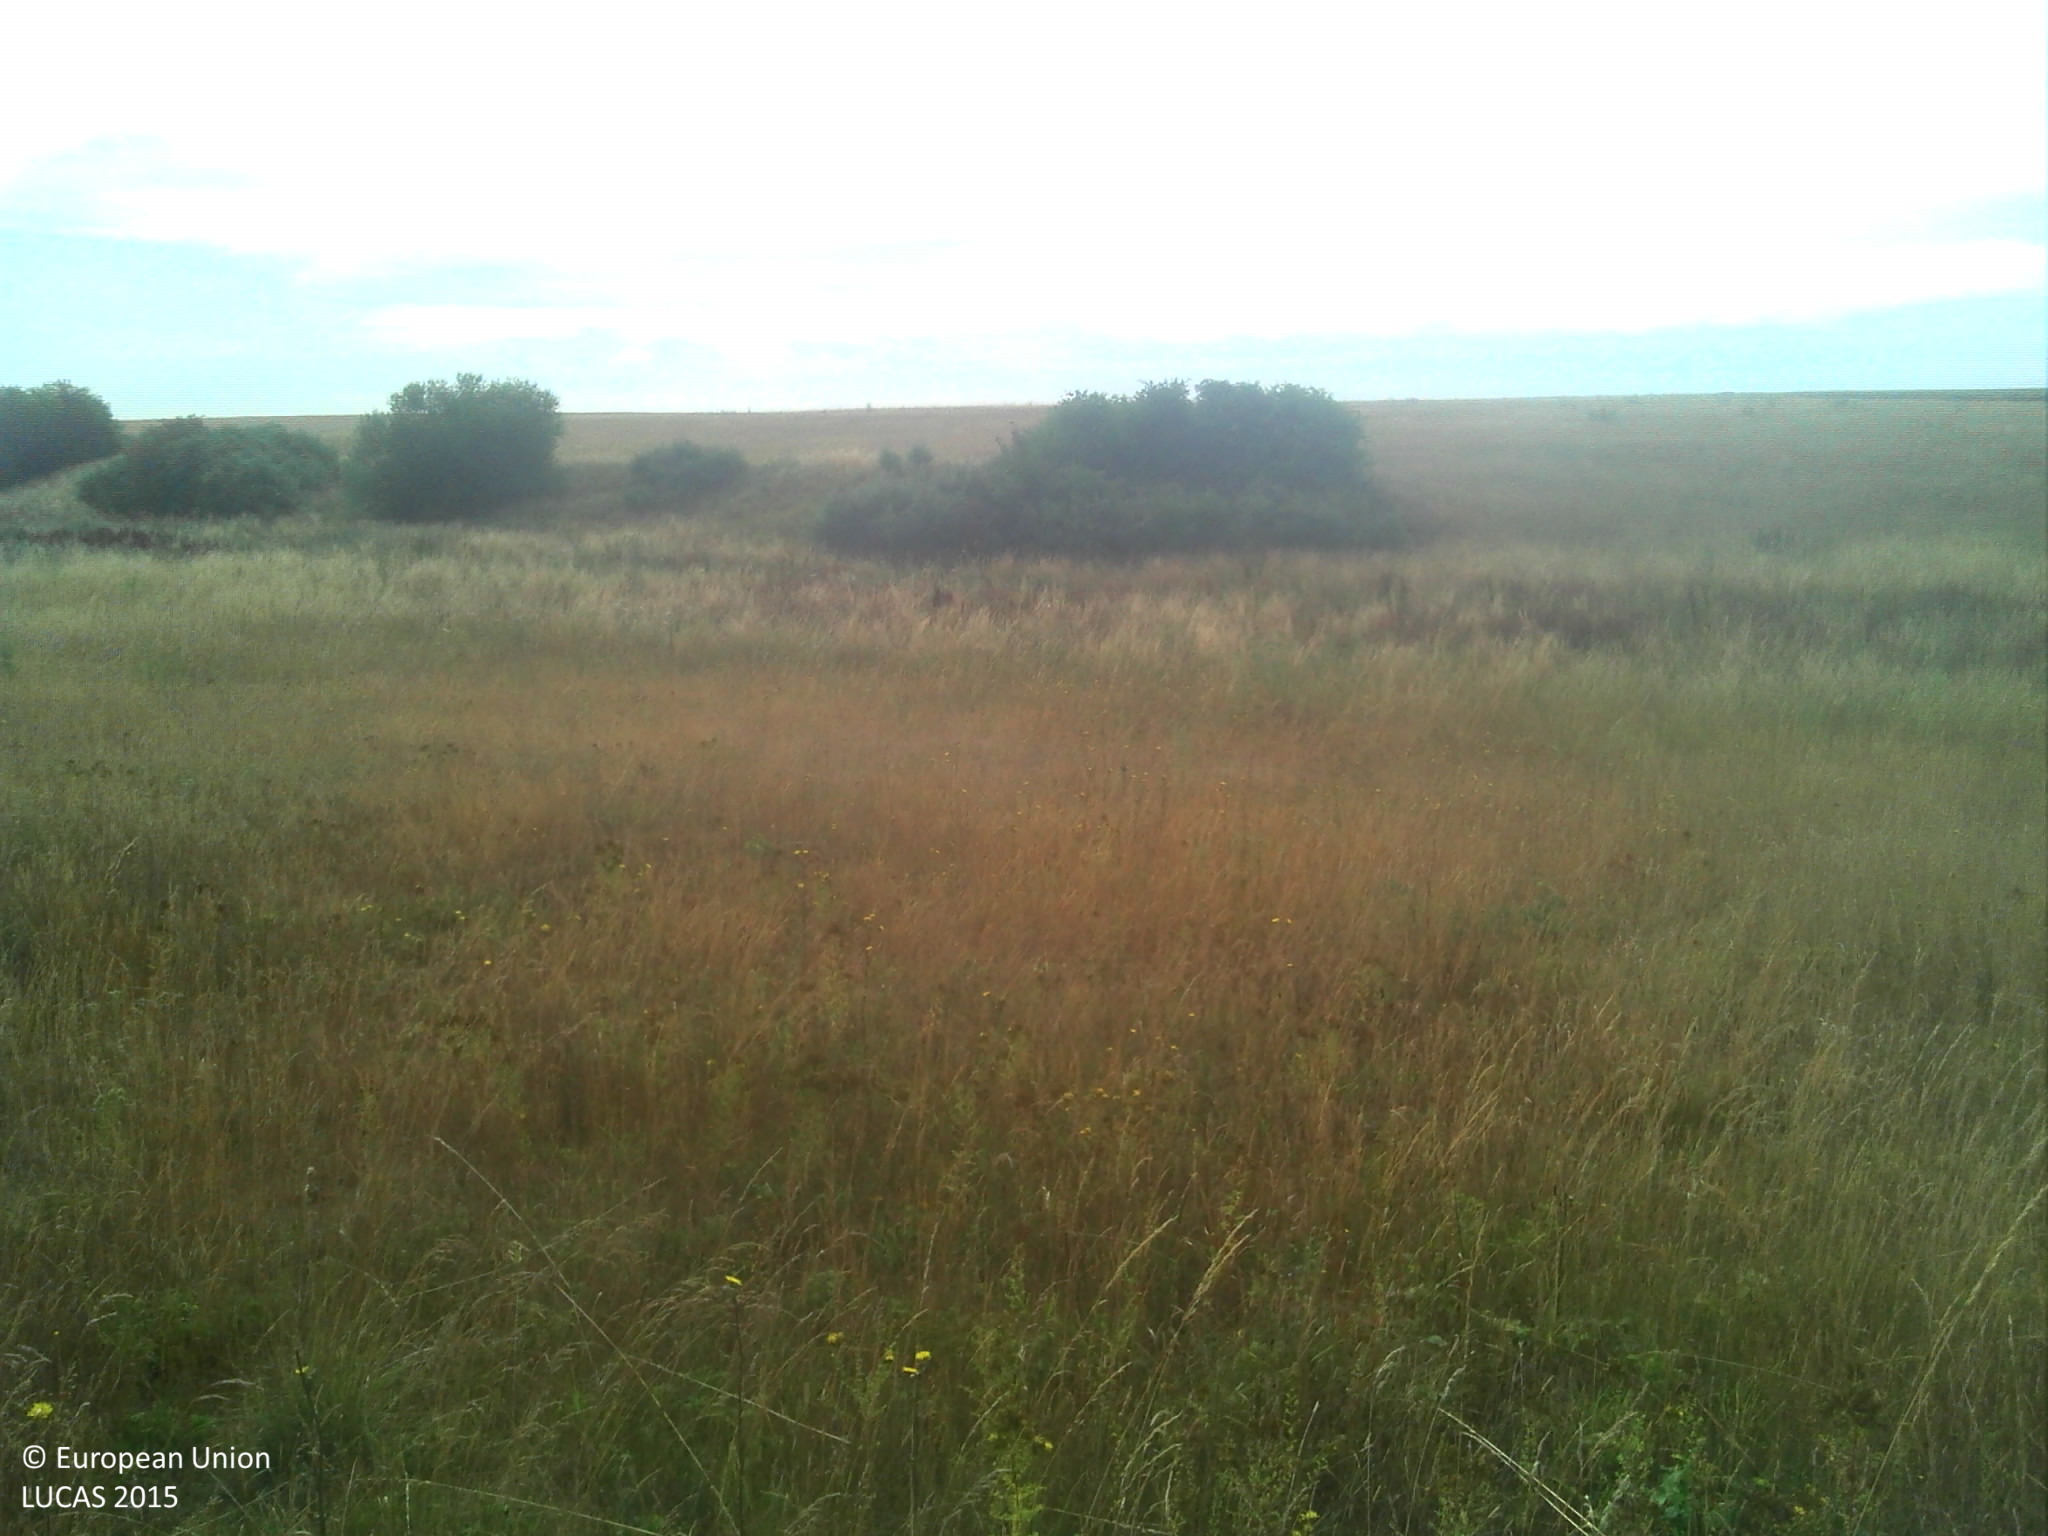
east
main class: Grassland
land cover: Grassland without tree/shrub cover
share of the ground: > 75 %
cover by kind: herbaceous plants 100 %
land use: Agriculture (excluding fallow land and kitchen gardens)
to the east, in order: Grassland without tree/shrub cover; Single bushes/trees; Grassland without tree/shrub cover; Rape and turnip rape
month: July
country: FR
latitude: 47.7923
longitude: 1.3471
